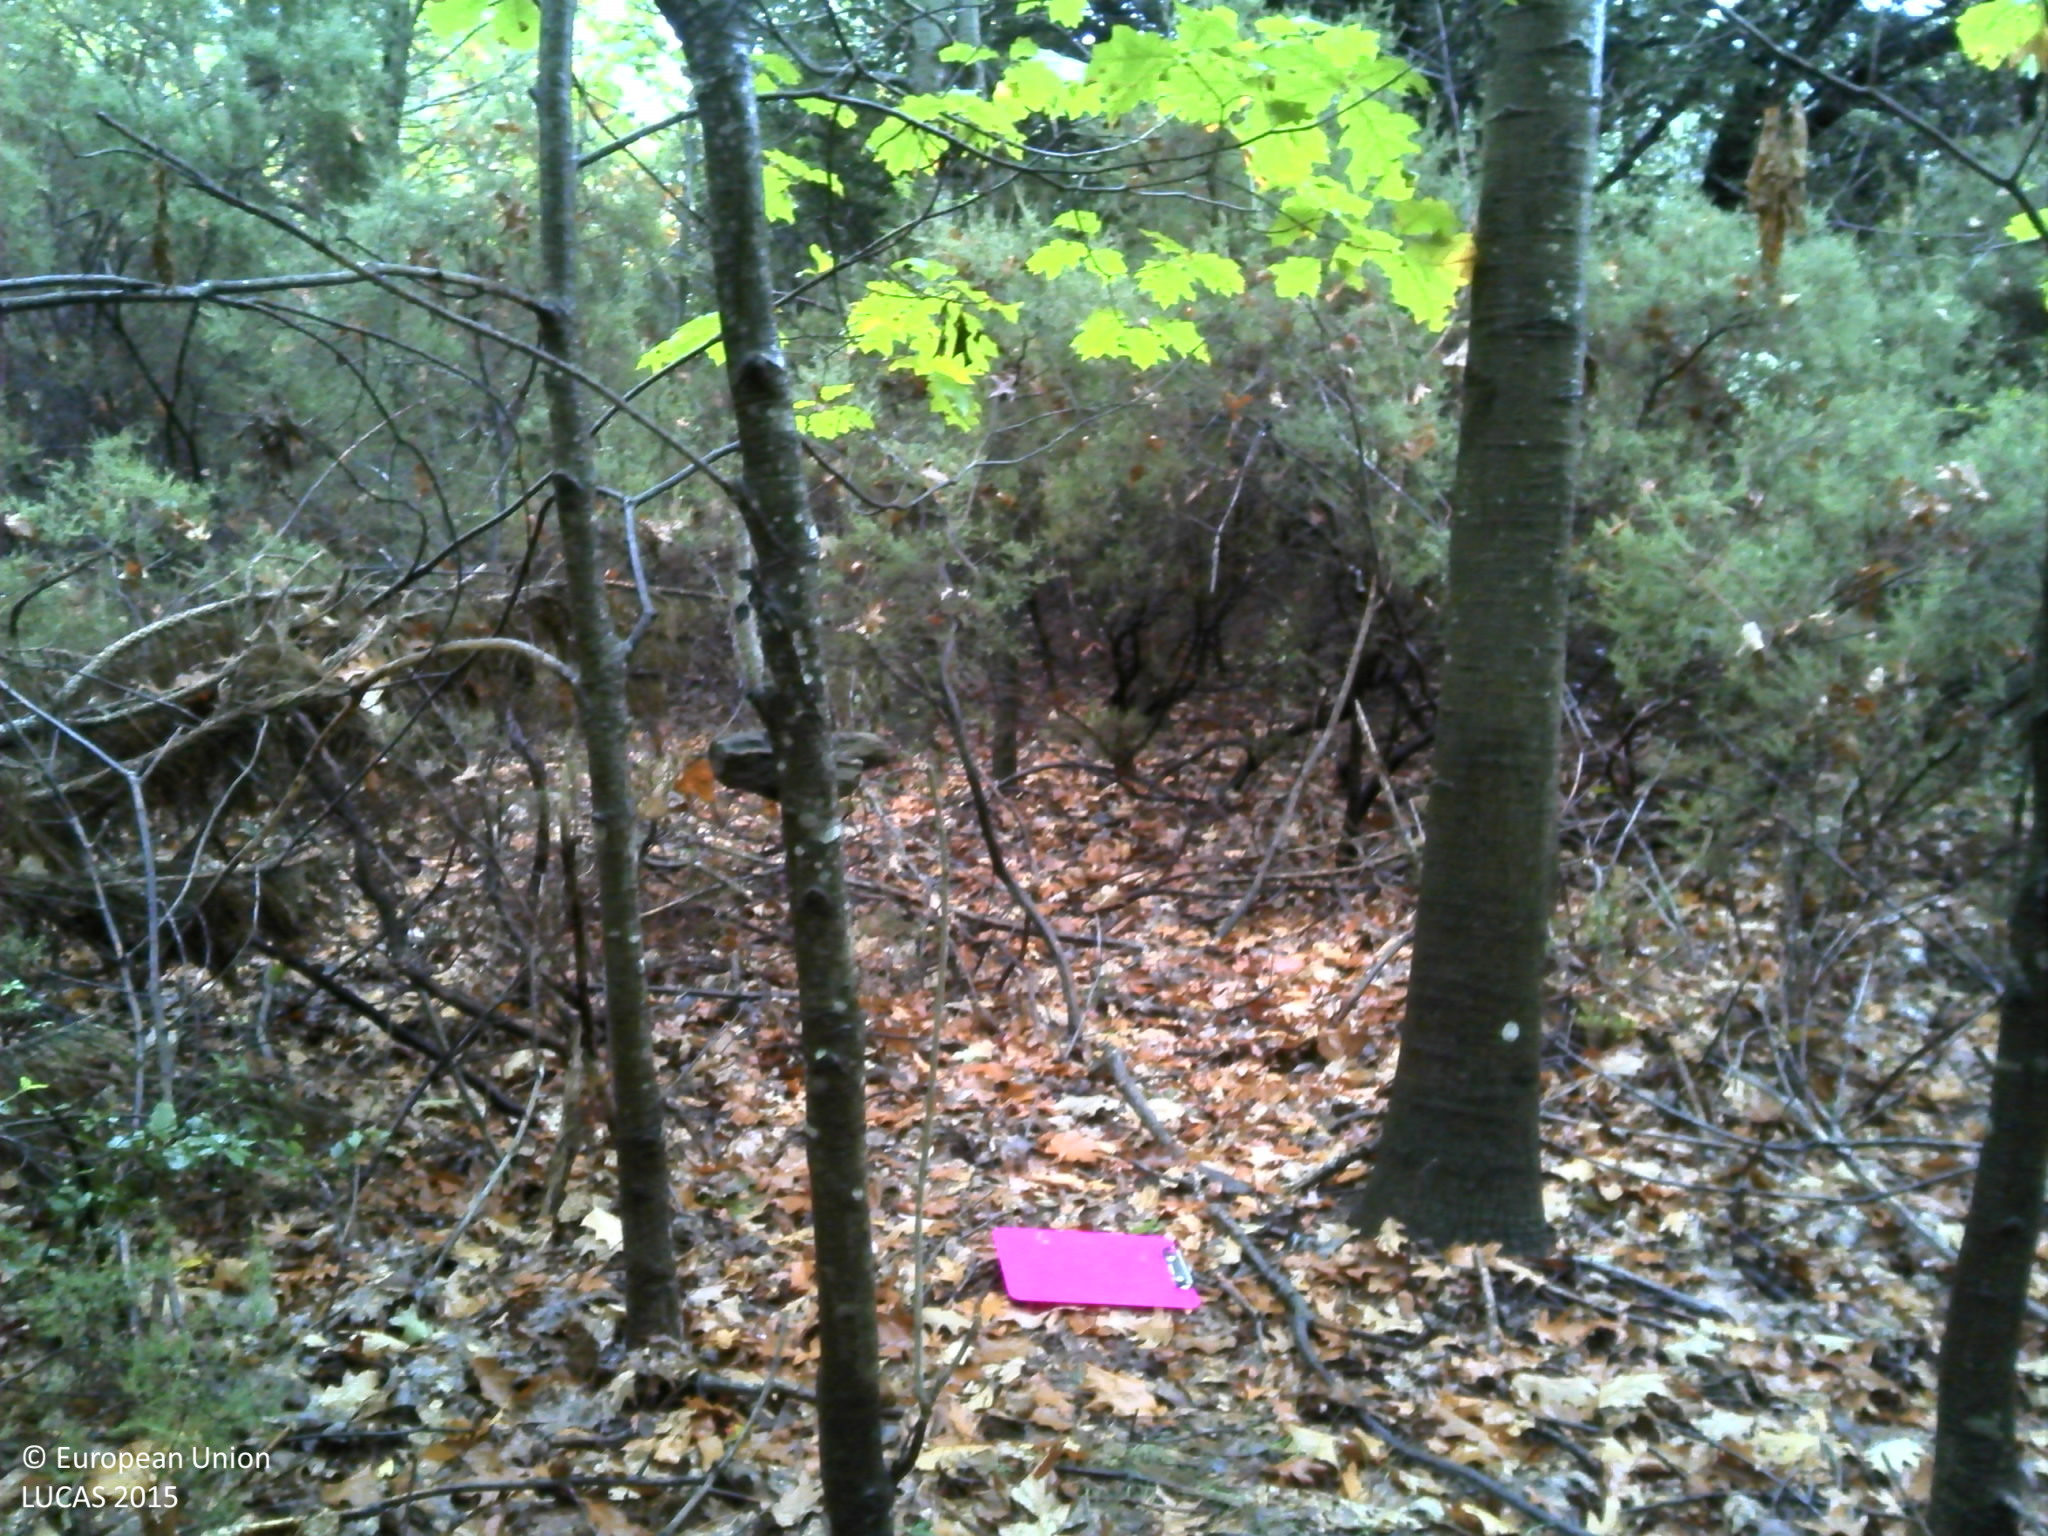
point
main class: Woodland
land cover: Pine dominated mixed woodland
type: mesophytic deciduous forest
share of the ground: > 75 %
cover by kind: coniferous forest trees 50 %, broadleaved forest trees 30 %, unconsolidated bare surface 20 %
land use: Forestry
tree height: > 5 m
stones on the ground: < 10 %
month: October
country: FR
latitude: 43.6110
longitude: 3.0570
